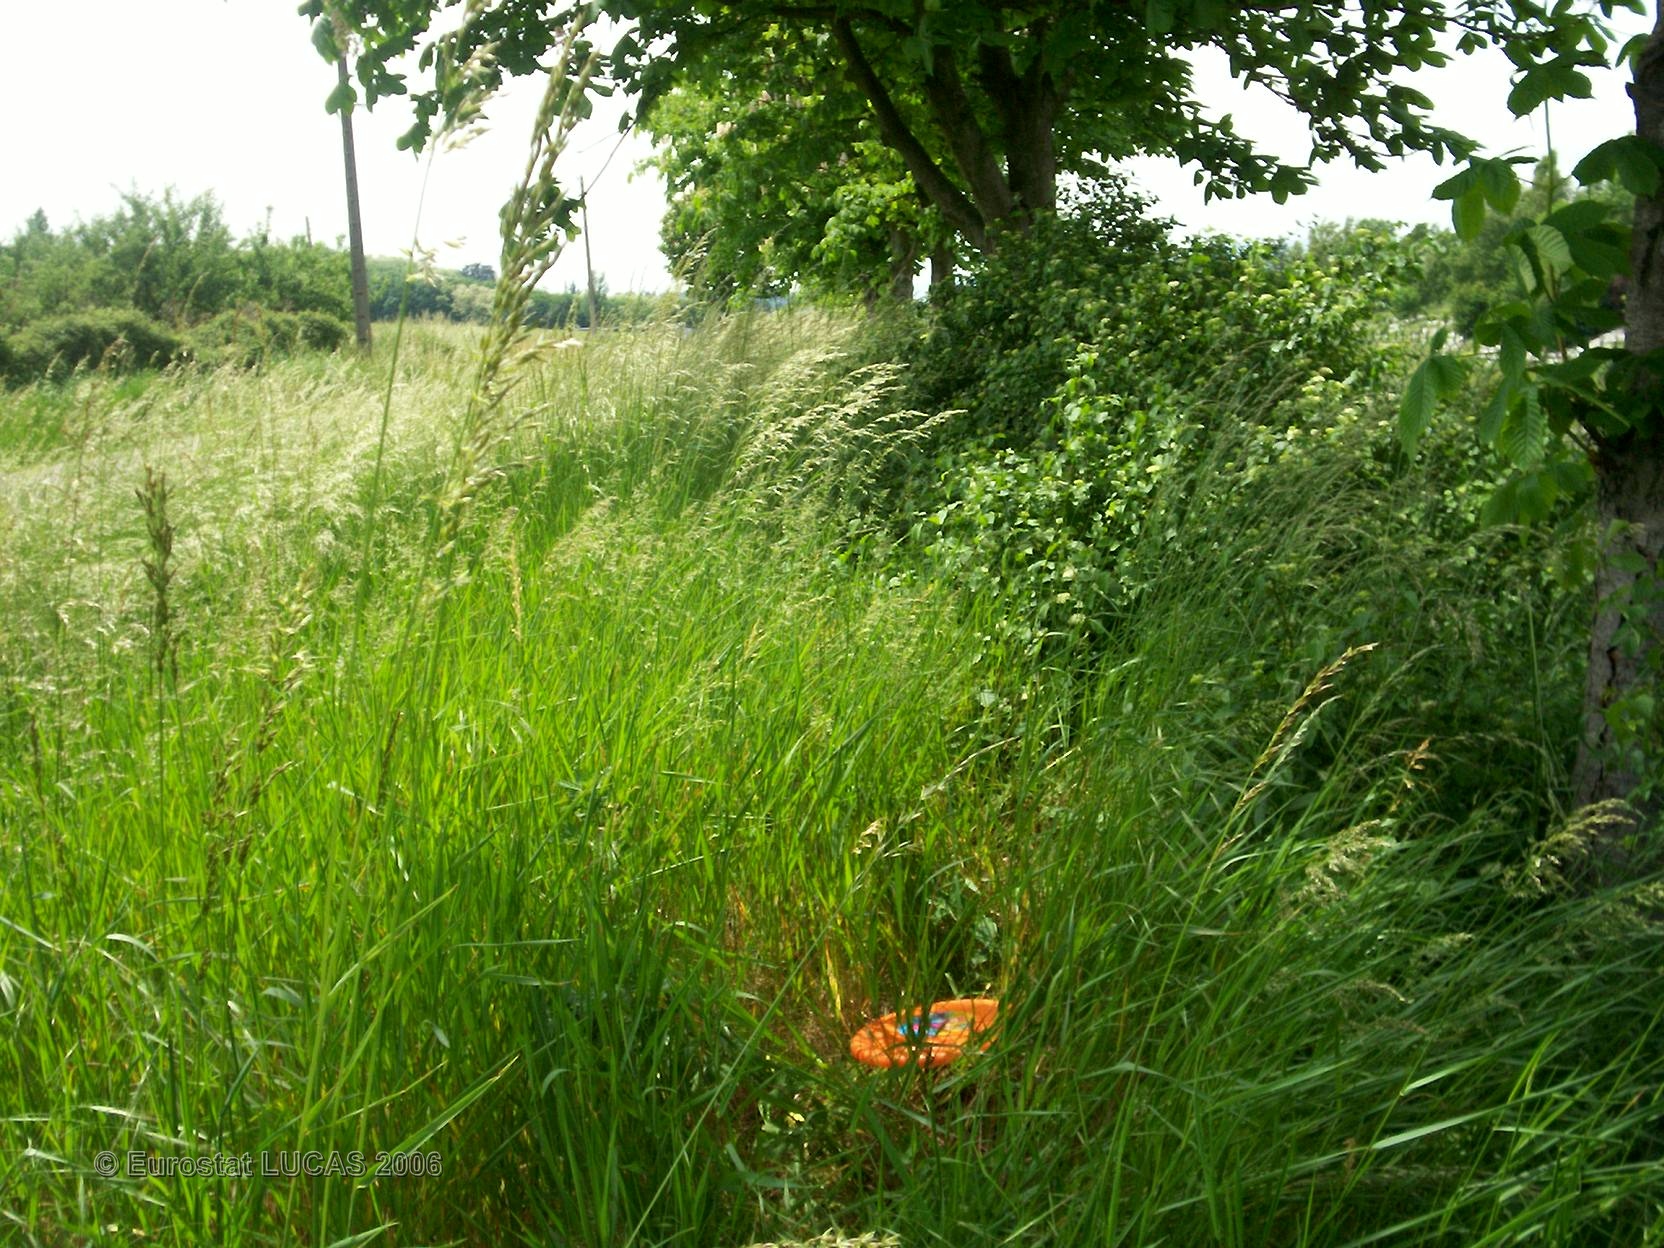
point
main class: Grassland
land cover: Grassland with sparse tree/shrub cover
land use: Unused
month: May
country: FR
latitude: 45.6834
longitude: 4.8038
